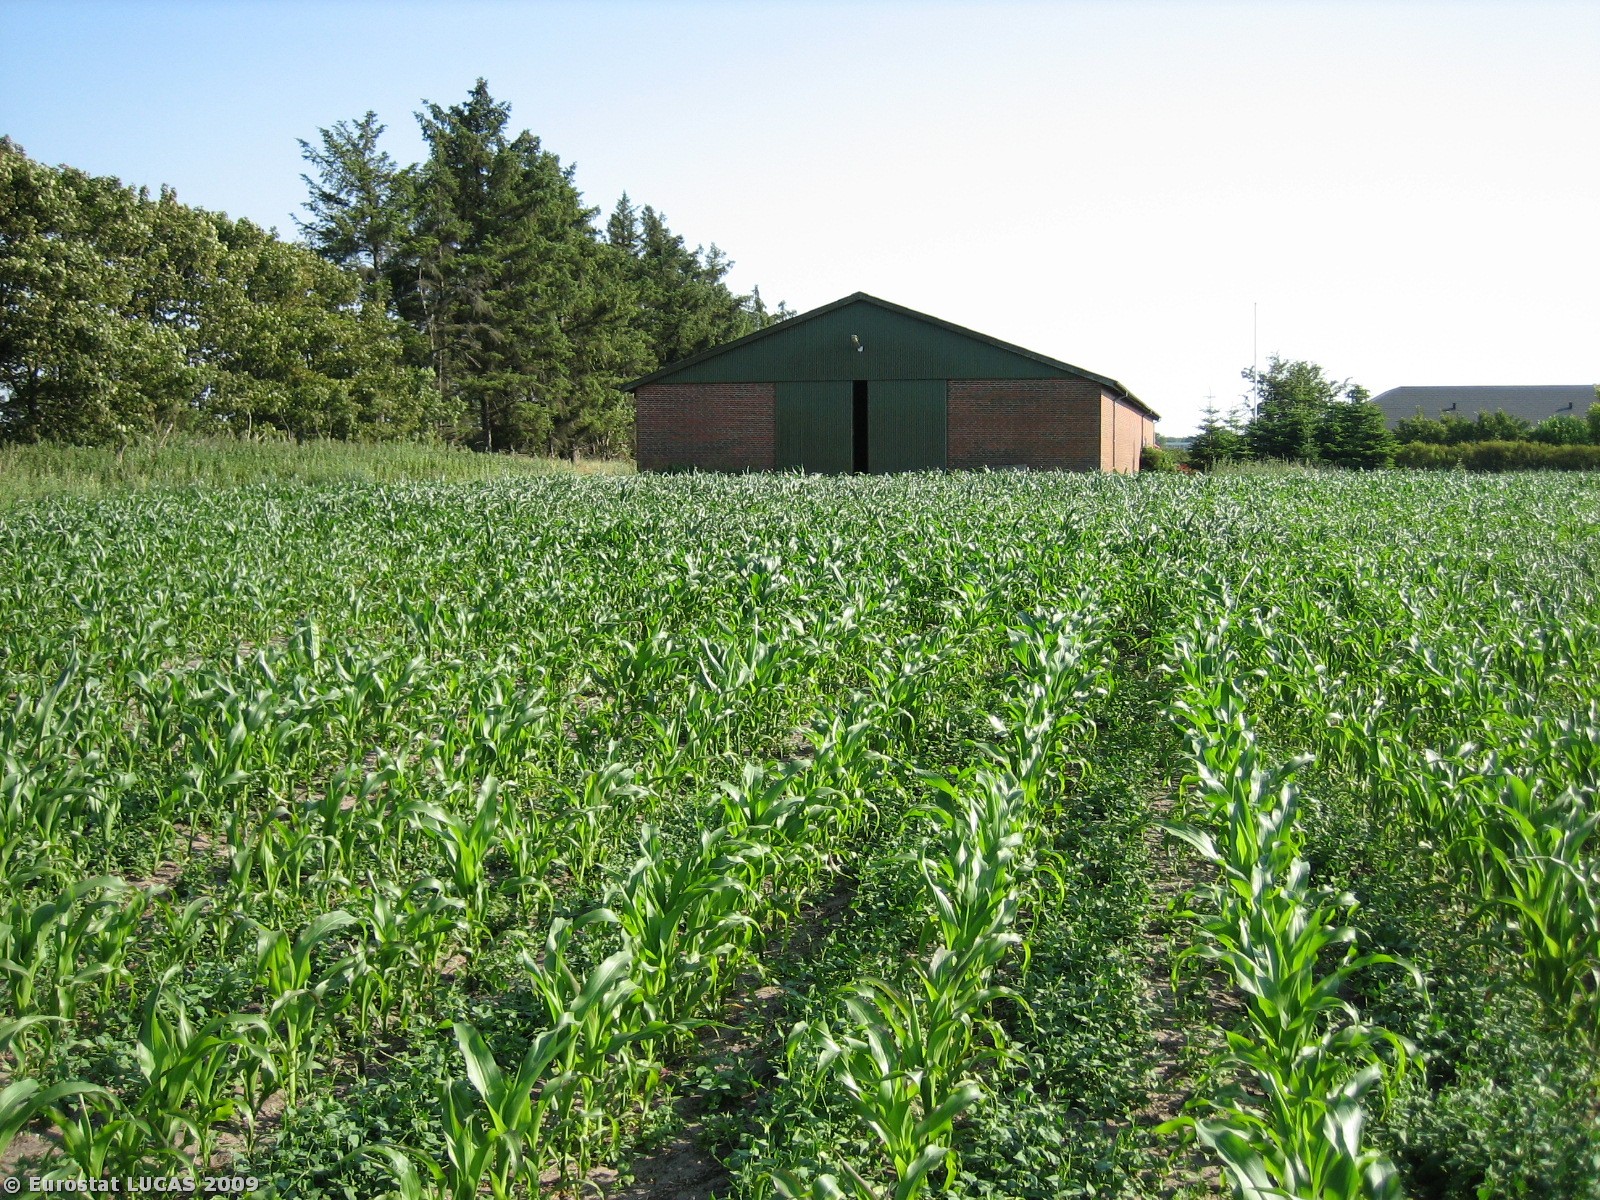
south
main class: Cropland
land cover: Maize
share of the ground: 25 - 50 %
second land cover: Dry pulses
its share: 50 - 75 %
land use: Agriculture (excluding fallow land and kitchen gardens)
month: July
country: DK
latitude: 55.3380
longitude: 8.8816
